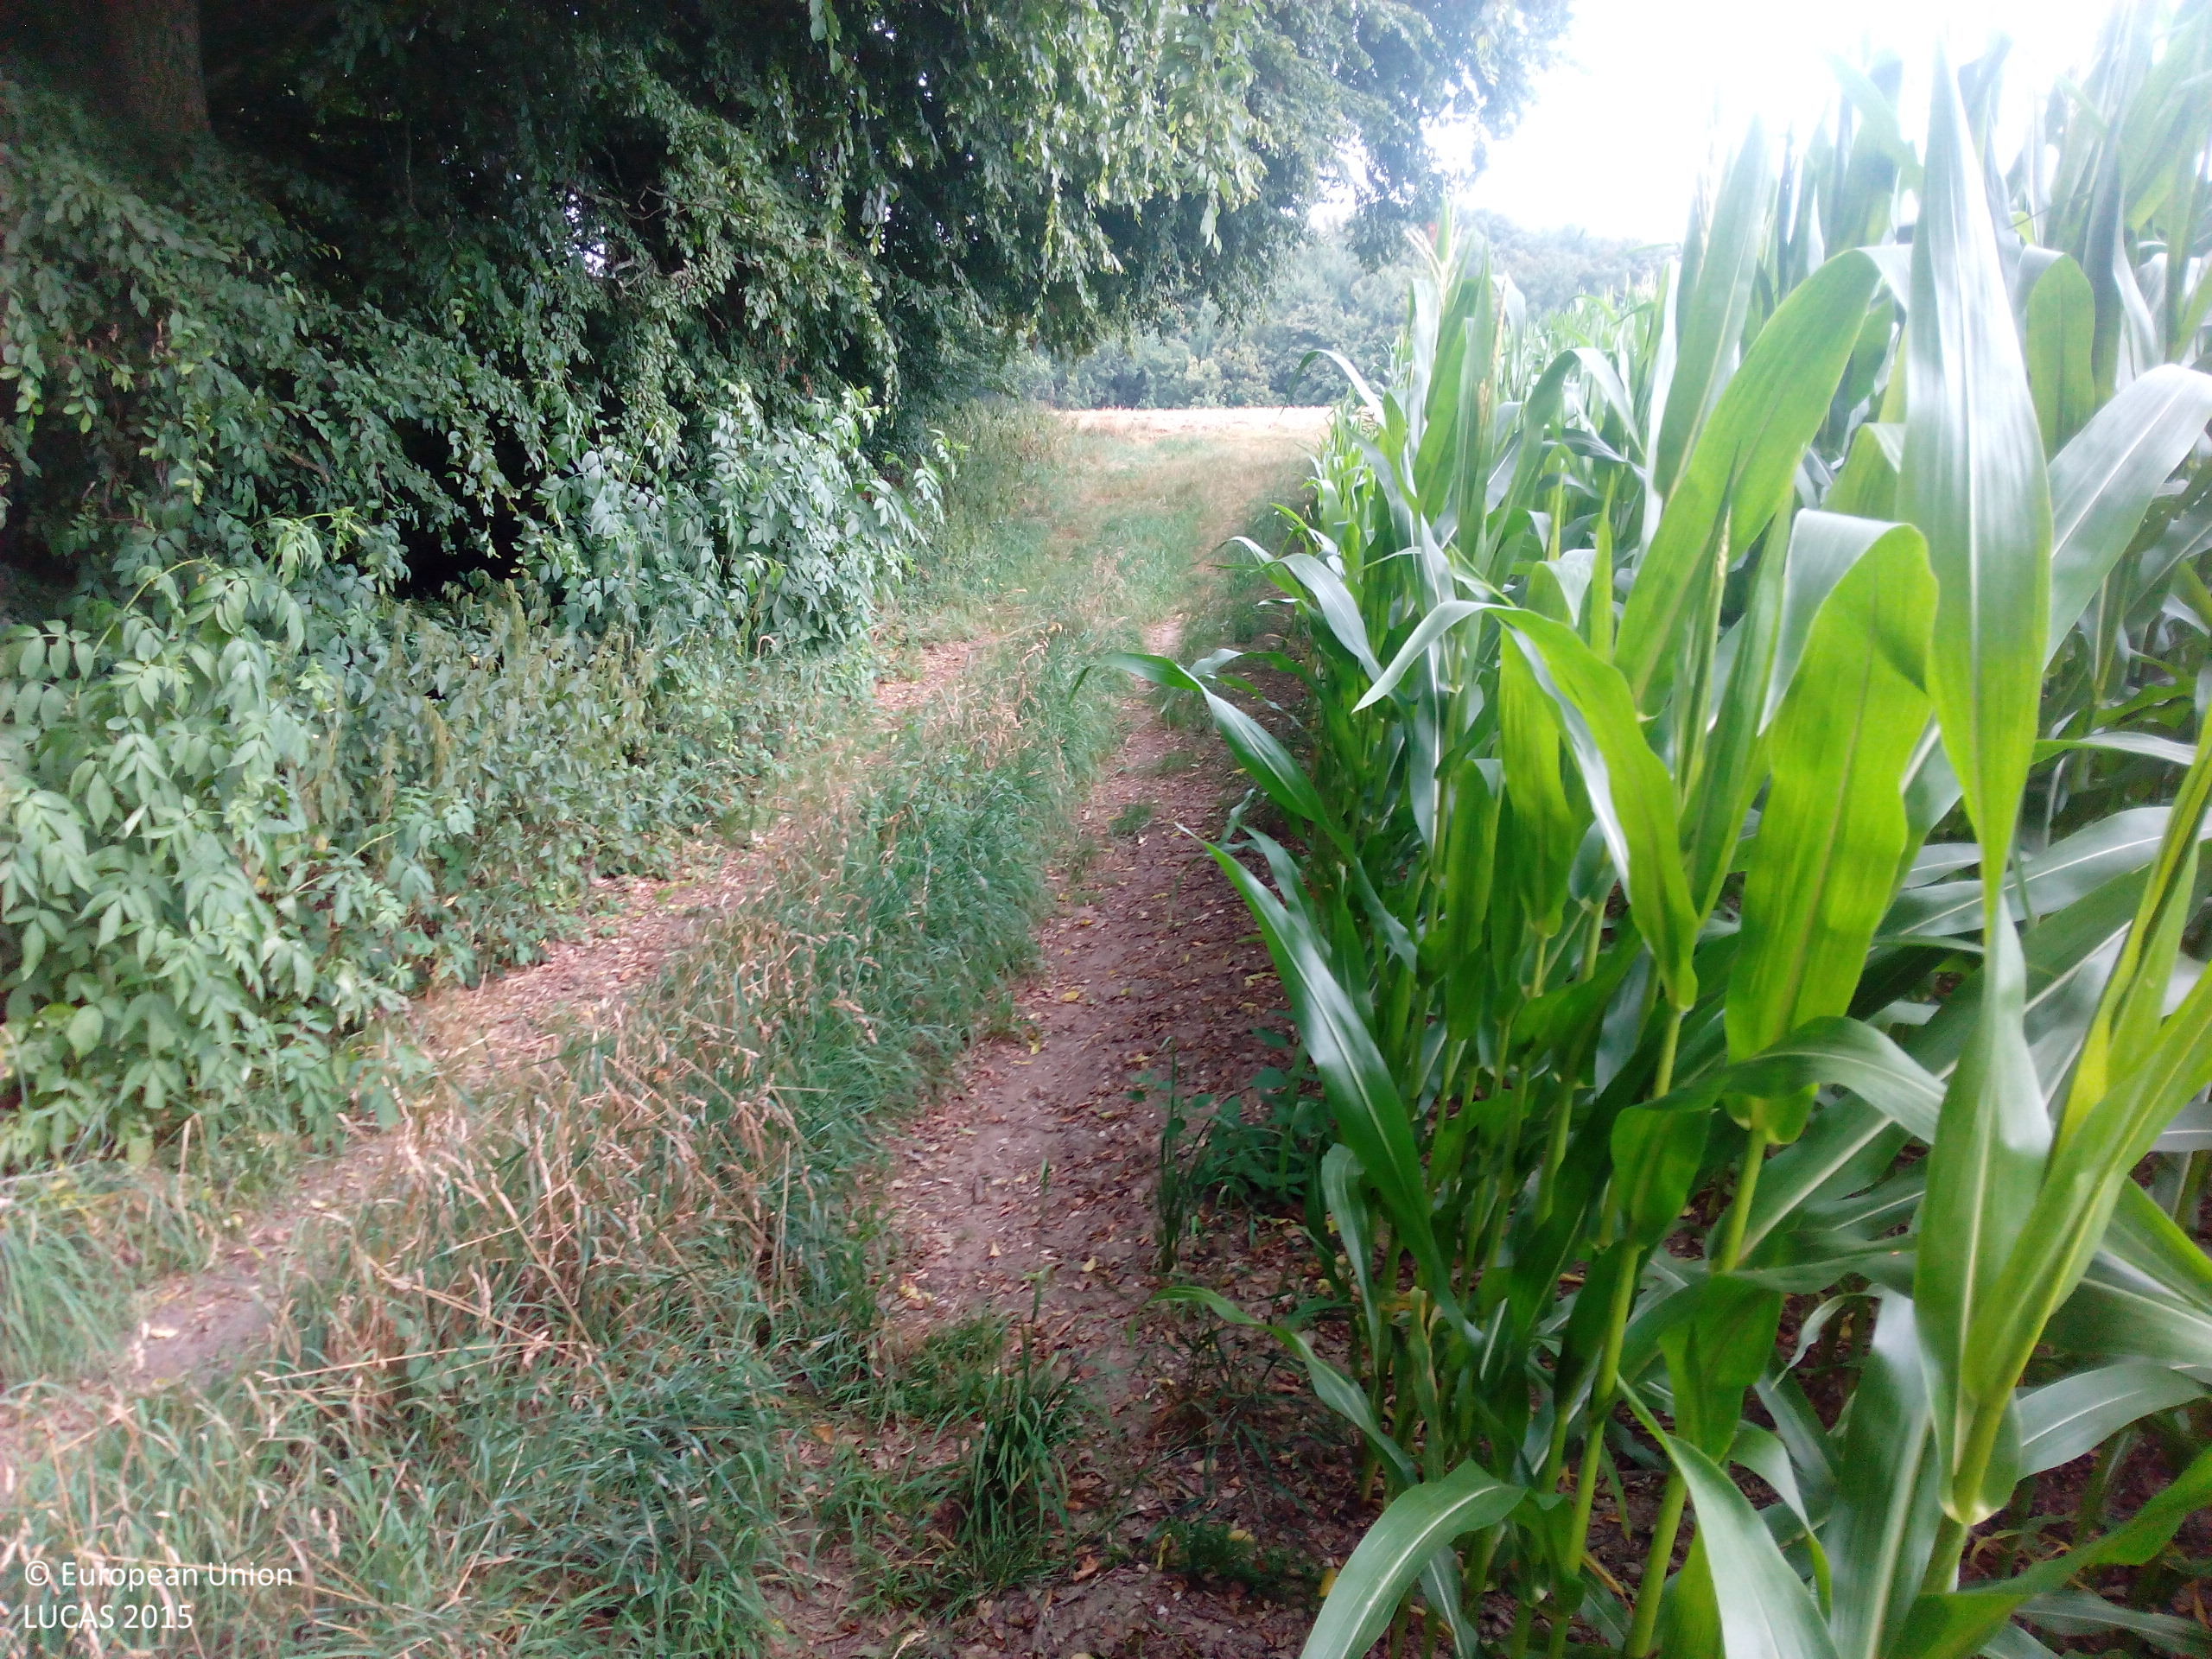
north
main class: Cropland
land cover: Maize
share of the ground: > 75 %
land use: Agriculture (excluding fallow land and kitchen gardens)
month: July
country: DE
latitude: 48.3115
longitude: 12.8981
